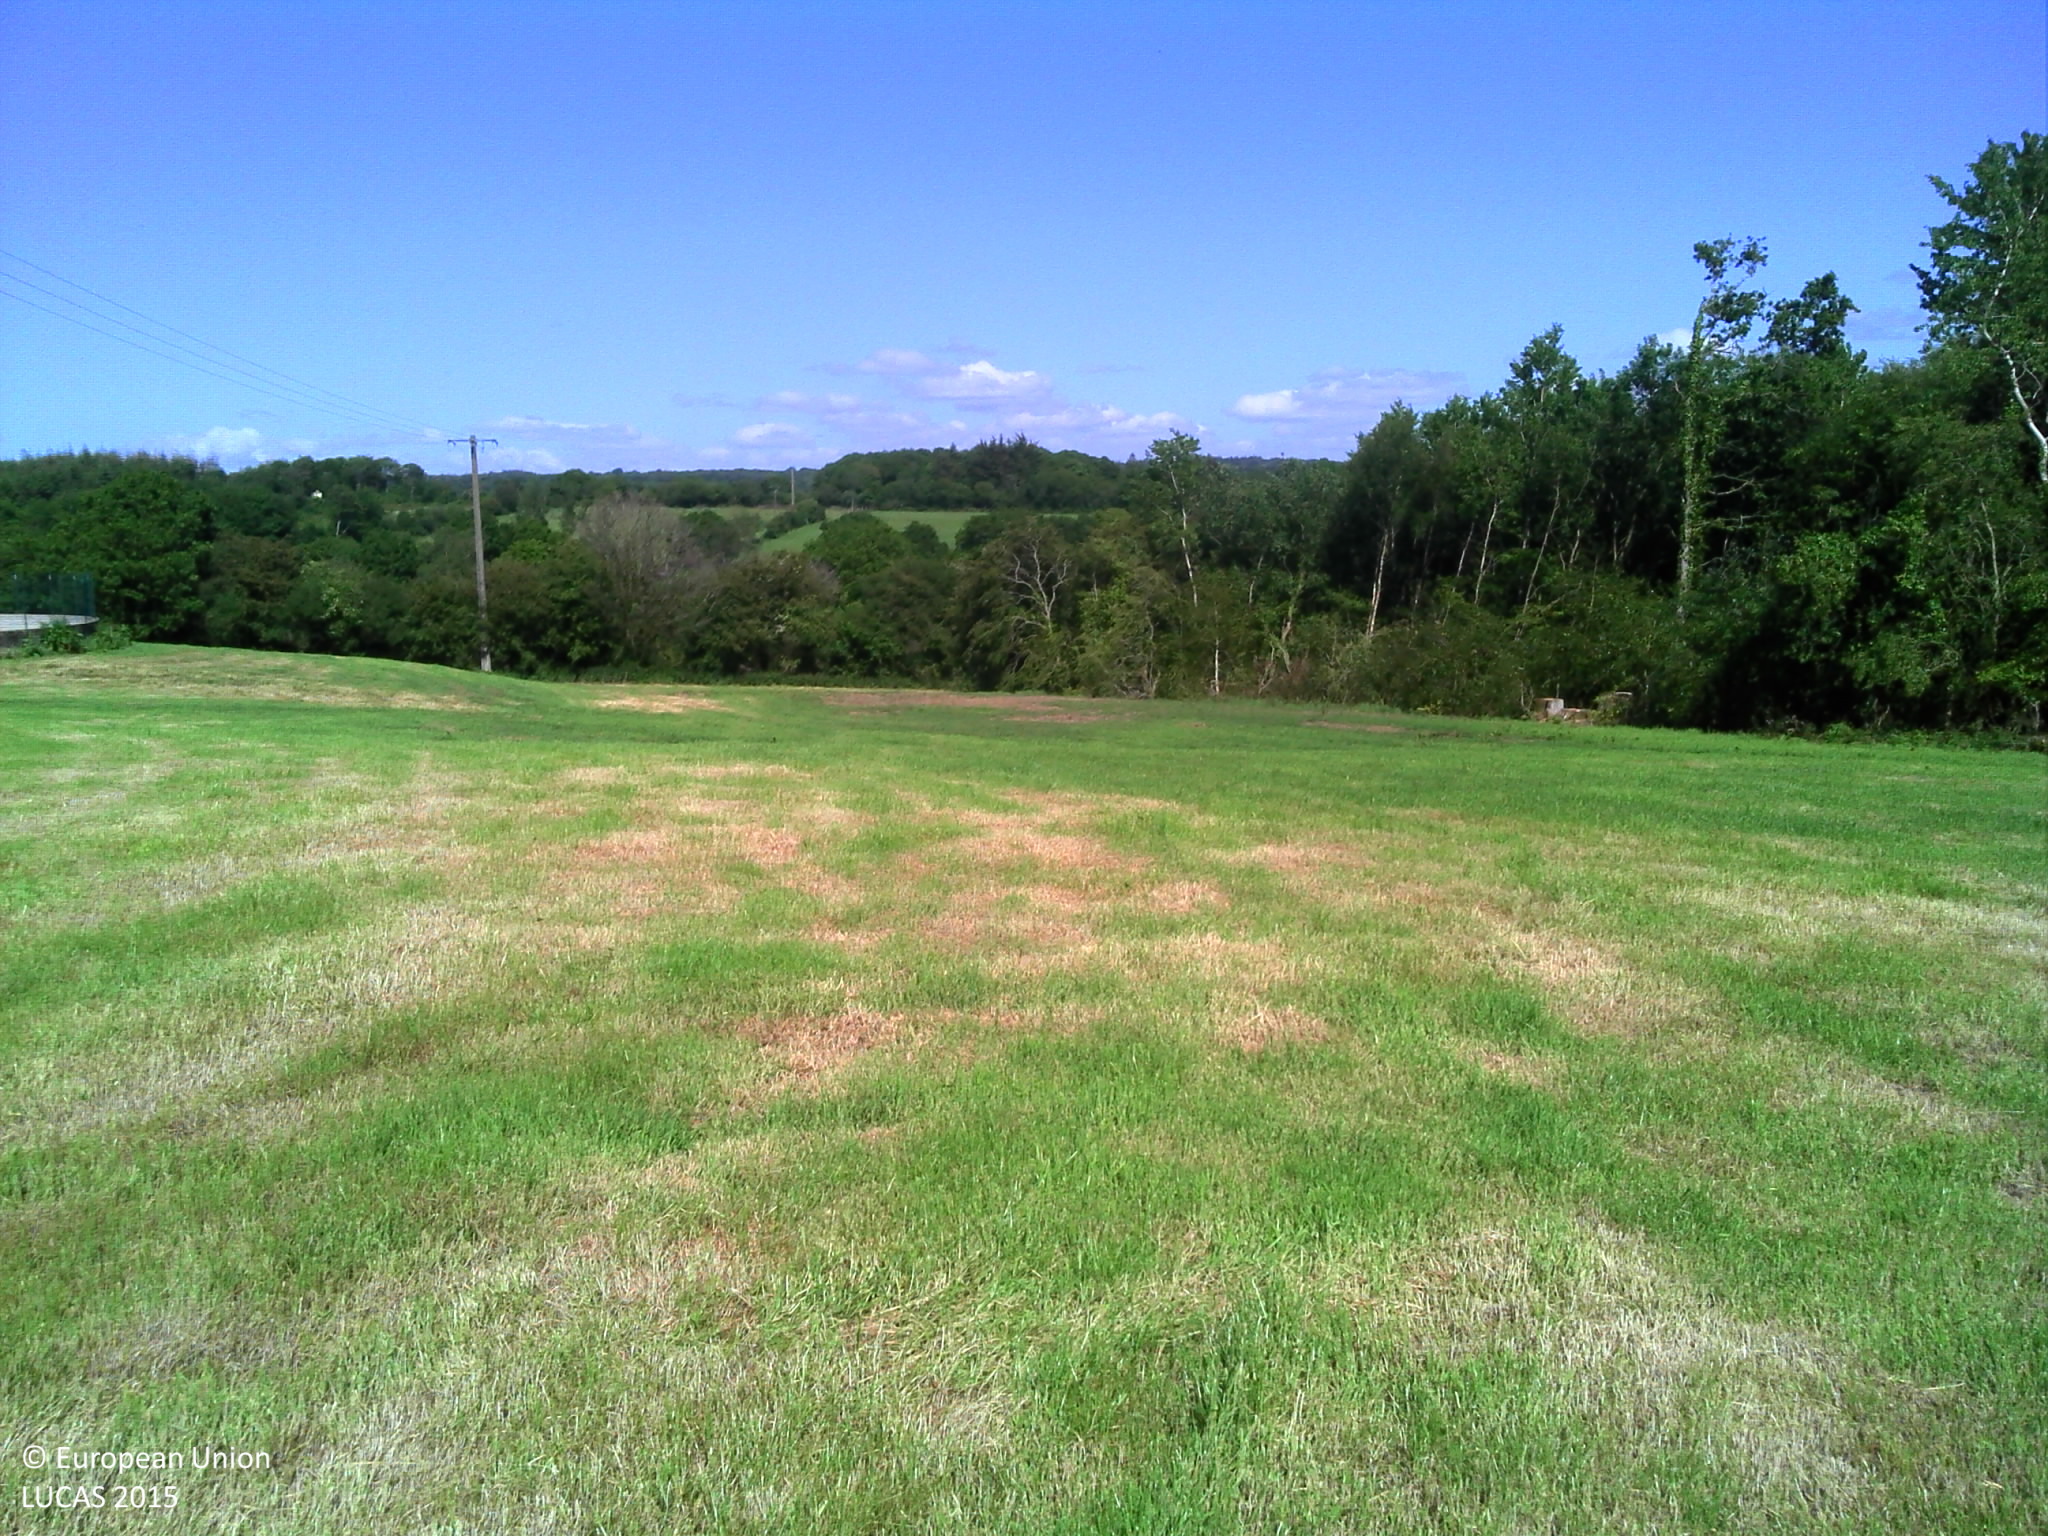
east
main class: Grassland
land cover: Grassland without tree/shrub cover
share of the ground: > 75 %
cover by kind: herbaceous plants 100 %
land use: Agriculture (excluding fallow land and kitchen gardens)
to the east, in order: Grassland without tree/shrub cover; Broadleaved woodland; Grassland without tree/shrub cover; Lines of trees; Grass margins; Fences; Grassland with sparse tree/shrub cover; Lines of trees; Fences; Grassland without tree/shrub cover; Broadleaved woodland; Rivers and streams; Grassland without tree/shrub cover
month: June
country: FR
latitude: 49.4691
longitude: -1.7127
